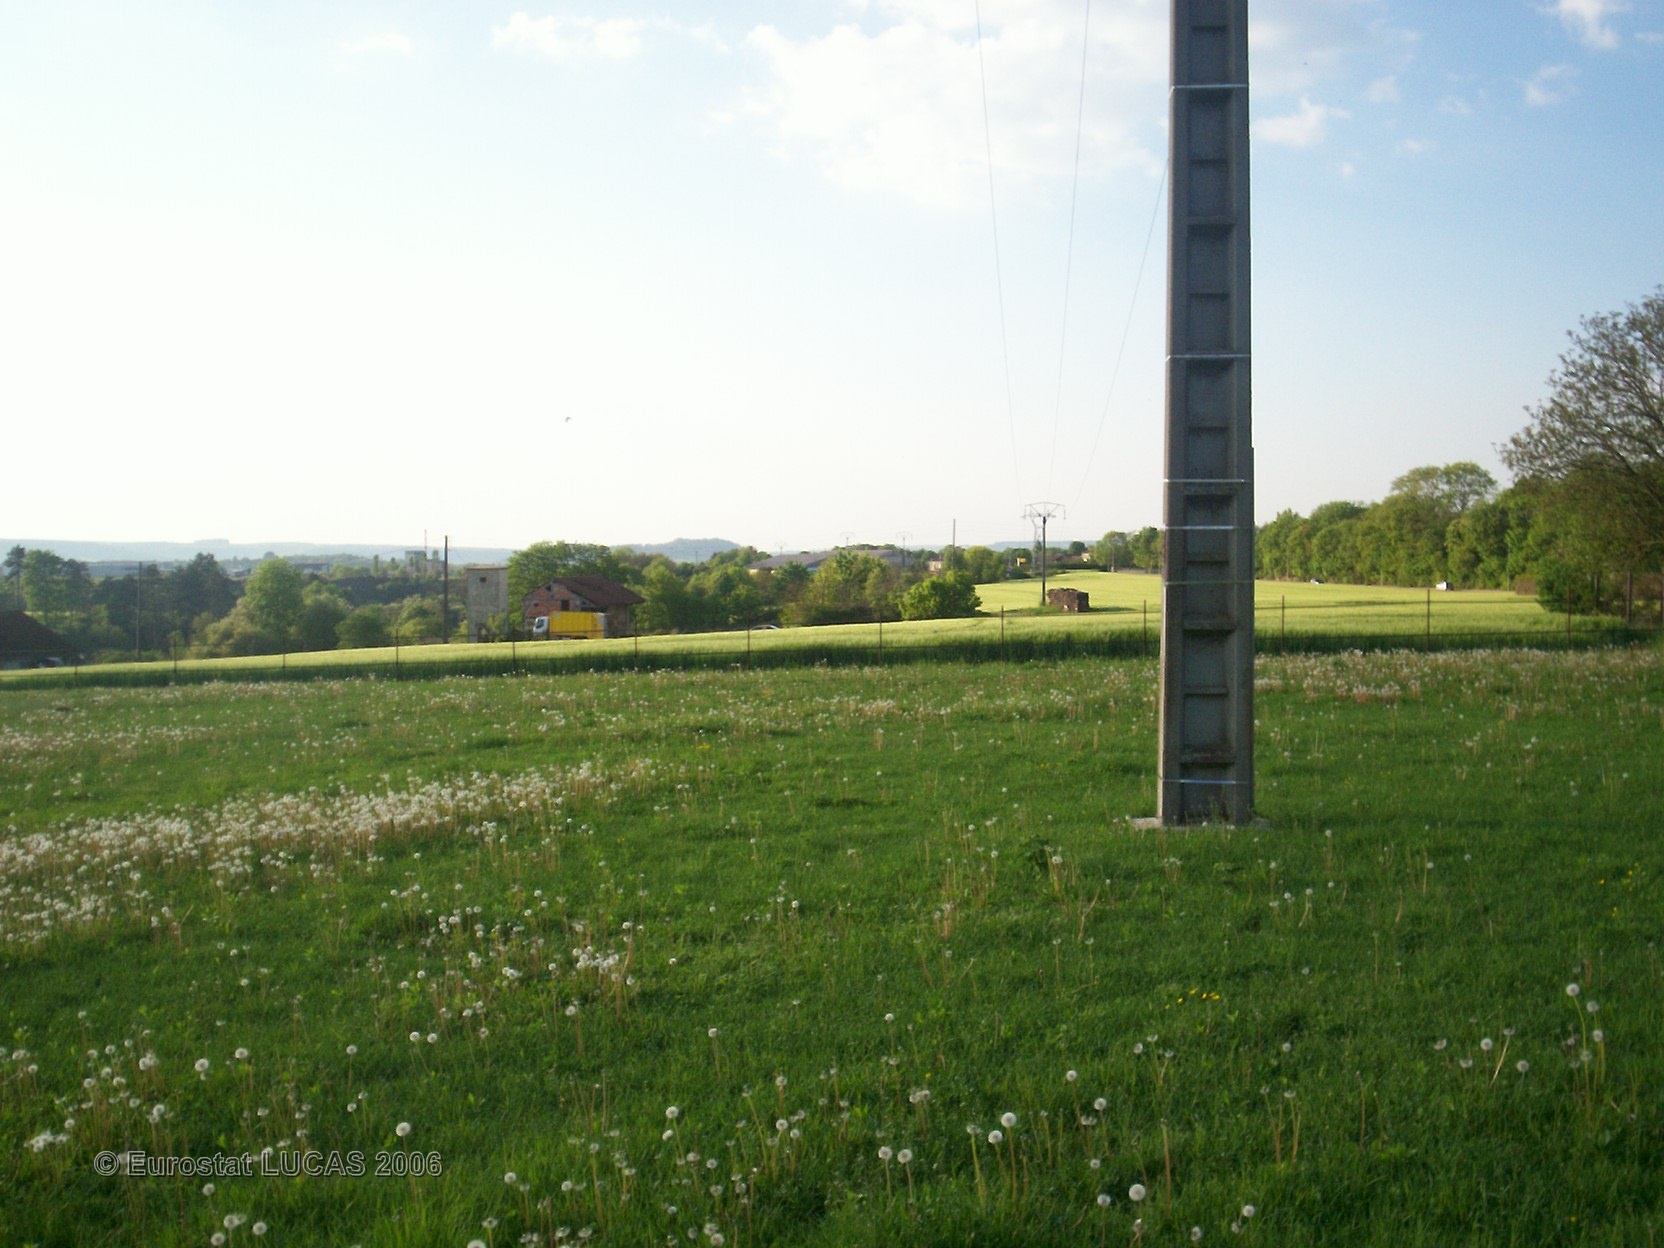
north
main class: Grassland
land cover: Grassland without tree/shrub cover
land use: Agriculture (excluding fallow land and kitchen gardens)
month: May
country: FR
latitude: 47.8547
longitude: 4.5588
